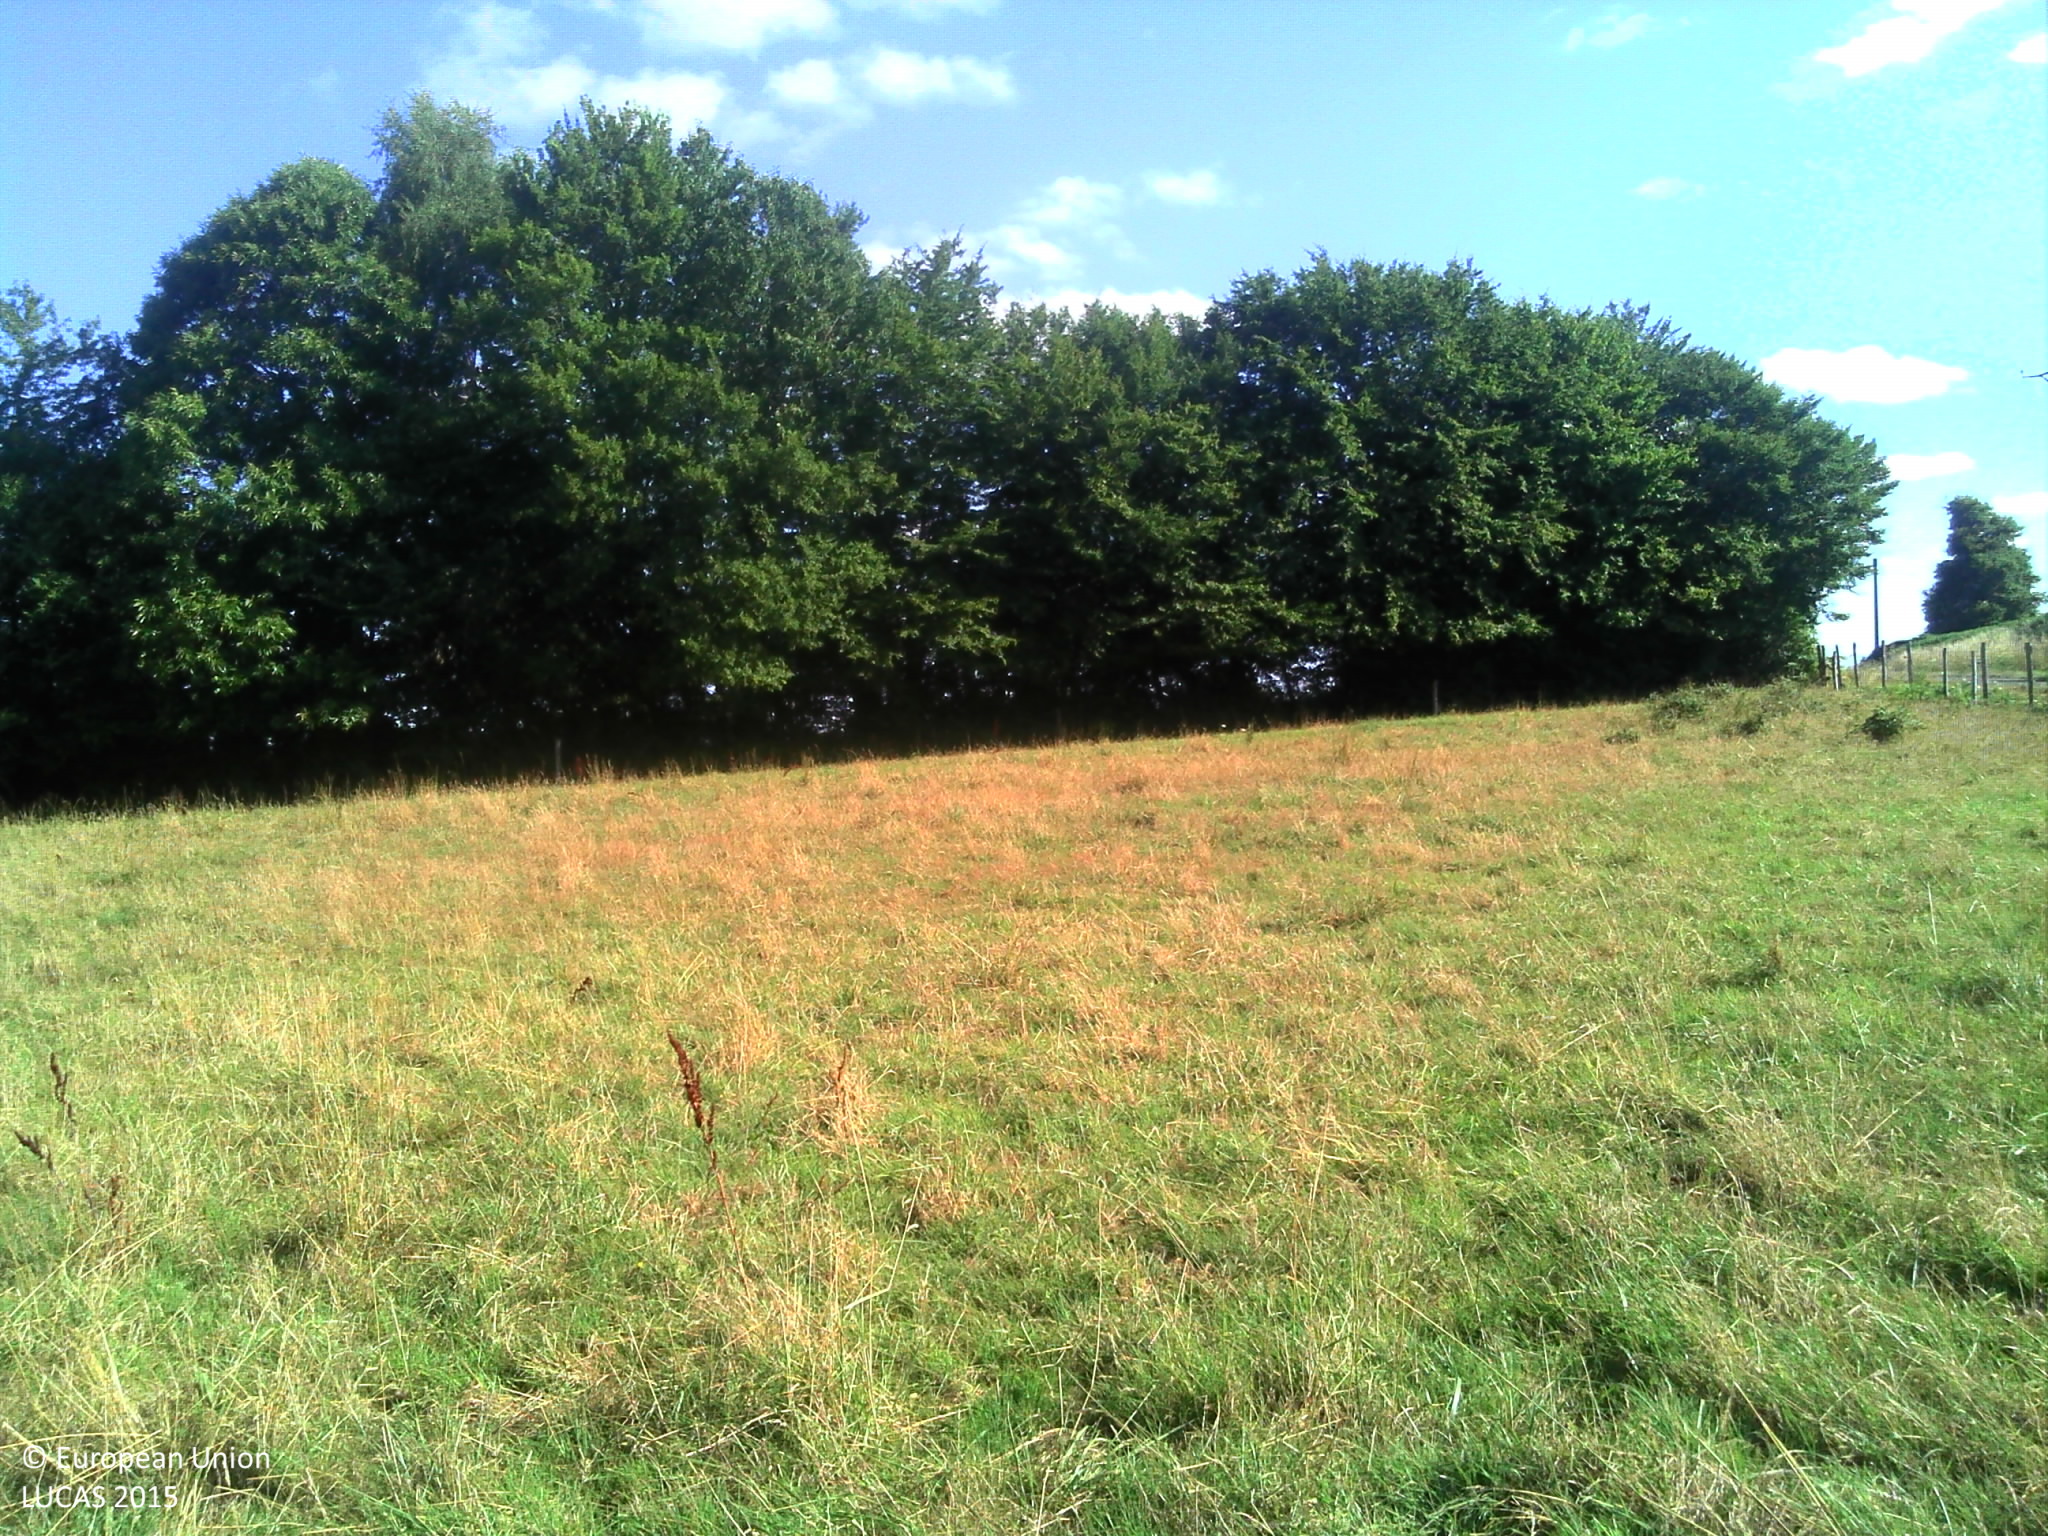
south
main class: Grassland
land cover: Grassland without tree/shrub cover
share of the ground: > 75 %
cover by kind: herbaceous plants 100 %
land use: Agriculture (excluding fallow land and kitchen gardens)
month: July
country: FR
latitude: 46.3072
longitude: 1.5639
